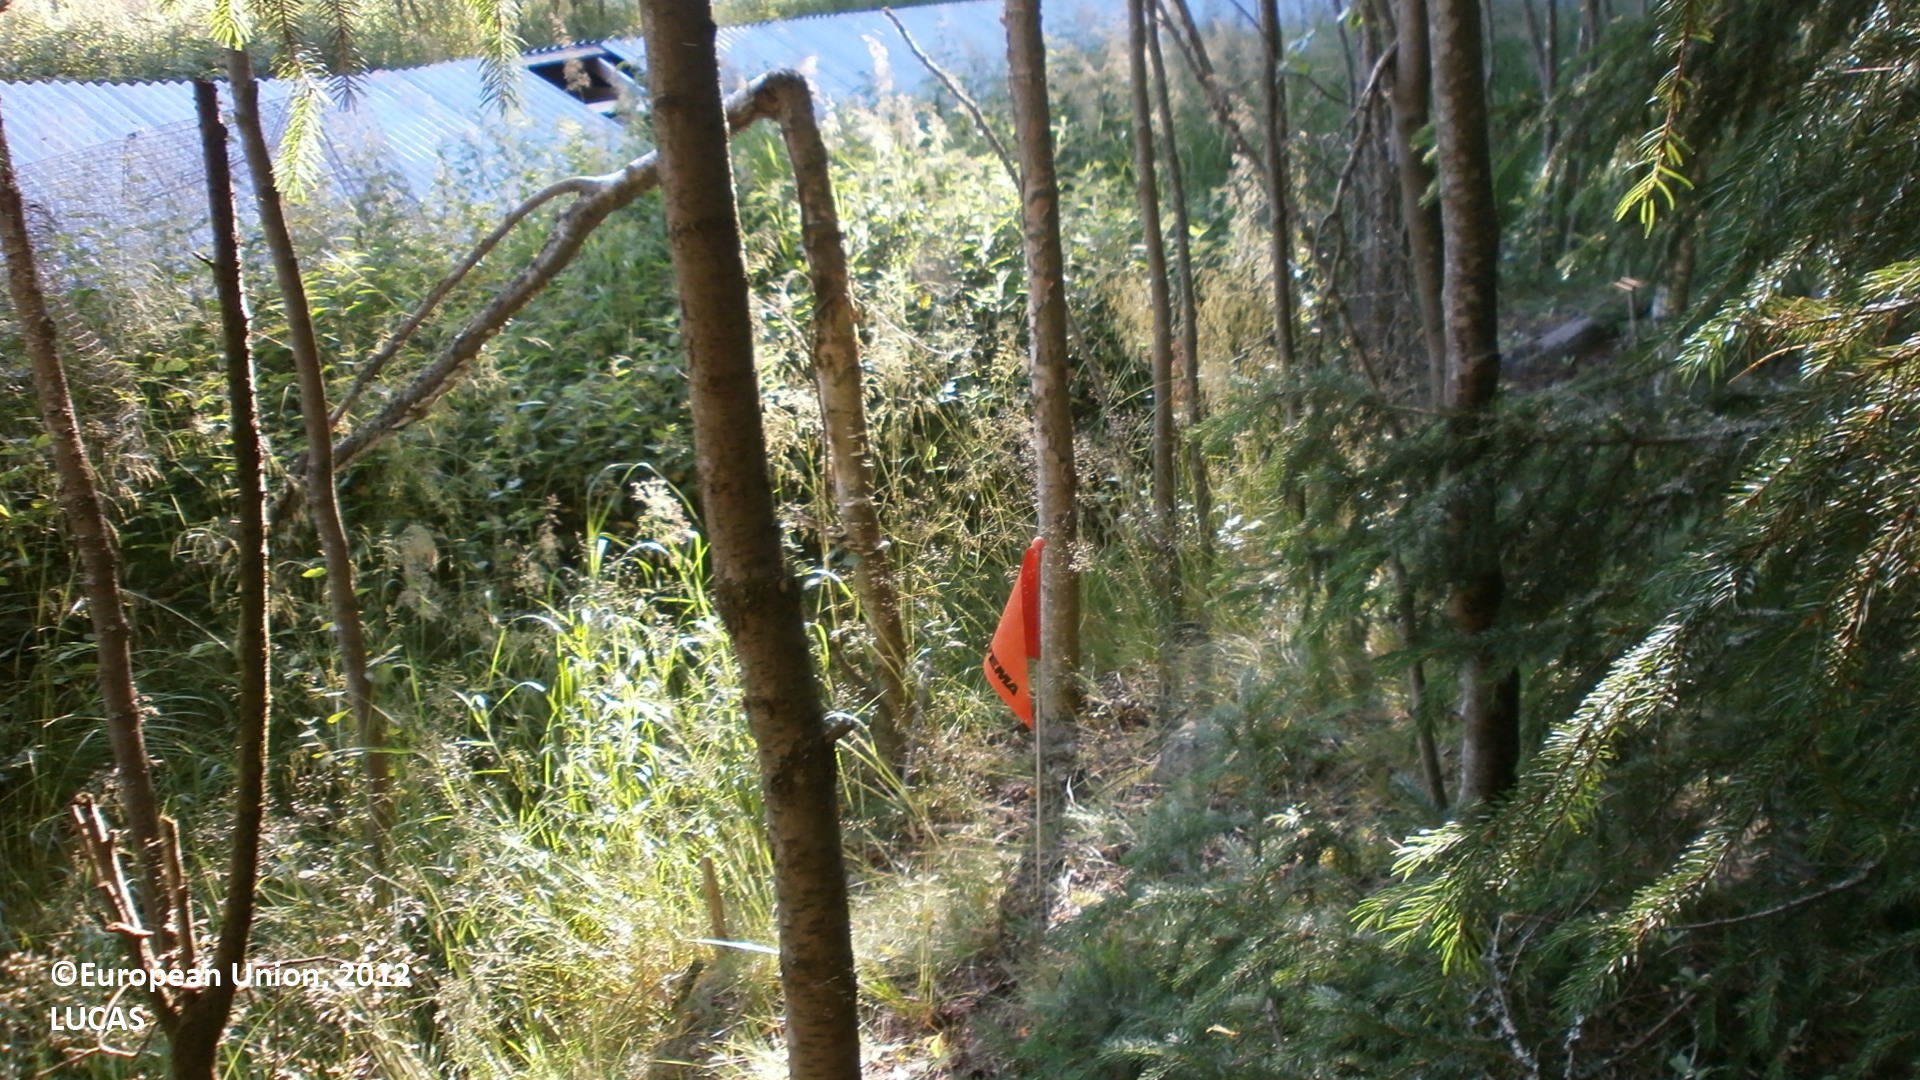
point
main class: Woodland
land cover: Spruce dominated mixed woodland
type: boreal forest
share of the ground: > 75 %
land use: Forestry
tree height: > 5 m
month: July
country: FI
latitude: 64.1156
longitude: 23.6704
